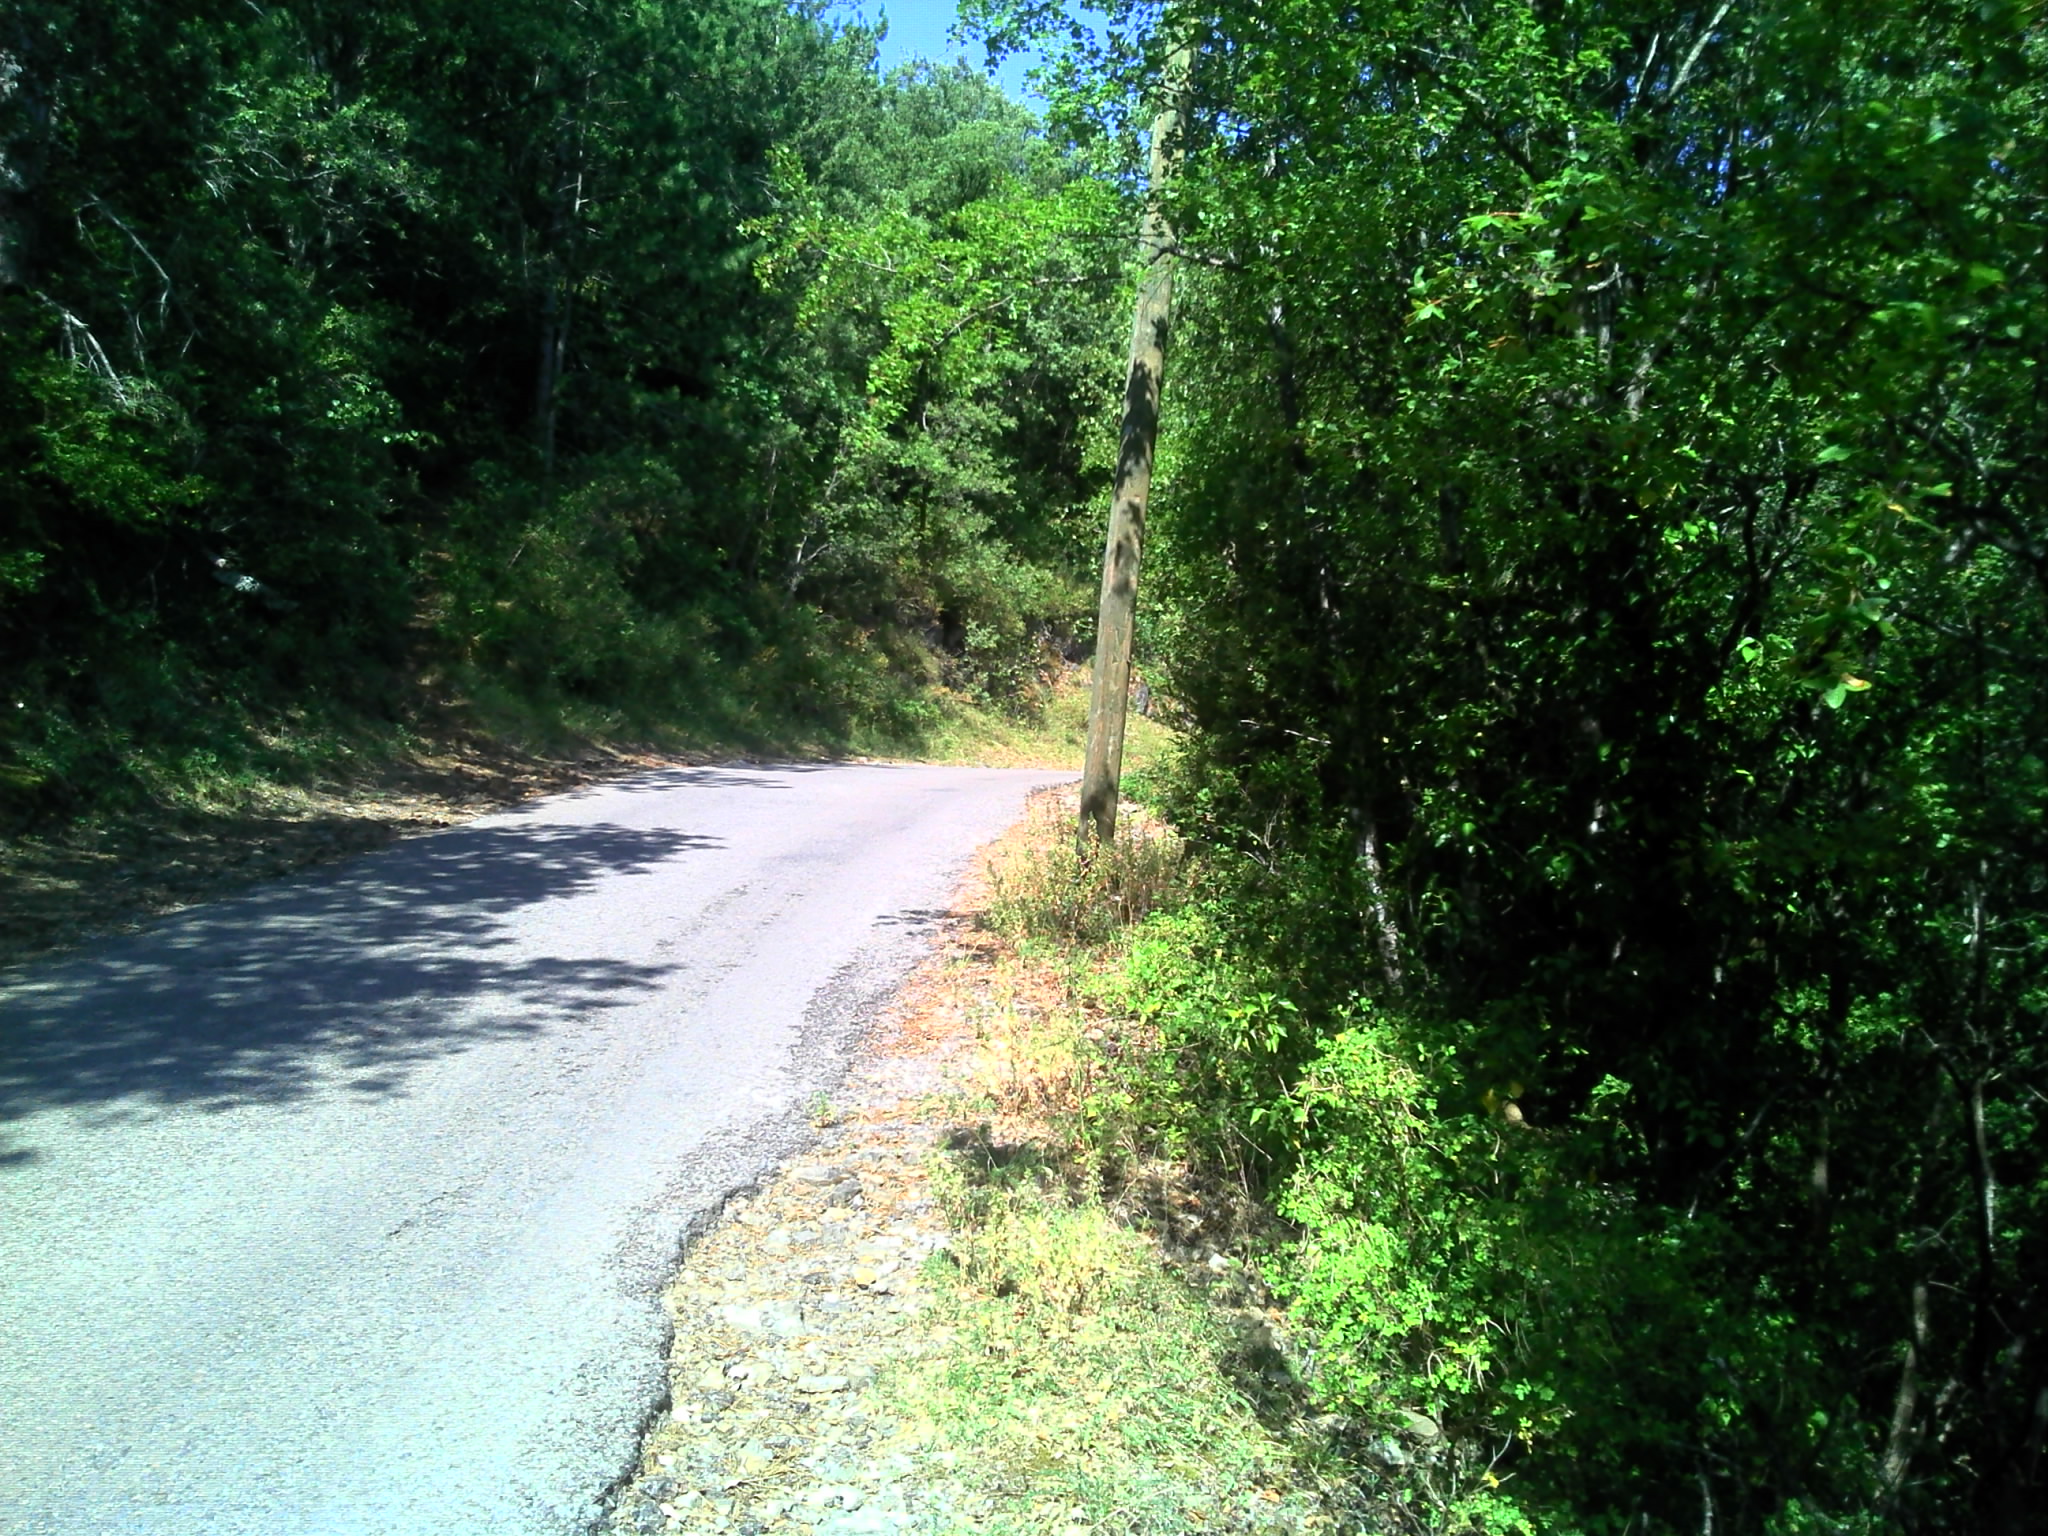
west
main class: Woodland
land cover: Broadleaved woodland
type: broadleaved evergreen forest
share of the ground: > 75 %
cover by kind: broadleaved forest trees 80 %, herbaceous plants 10 %, unconsolidated bare surface 10 %
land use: Forestry
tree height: > 5 m
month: October
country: FR
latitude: 44.0072
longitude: 3.5840
